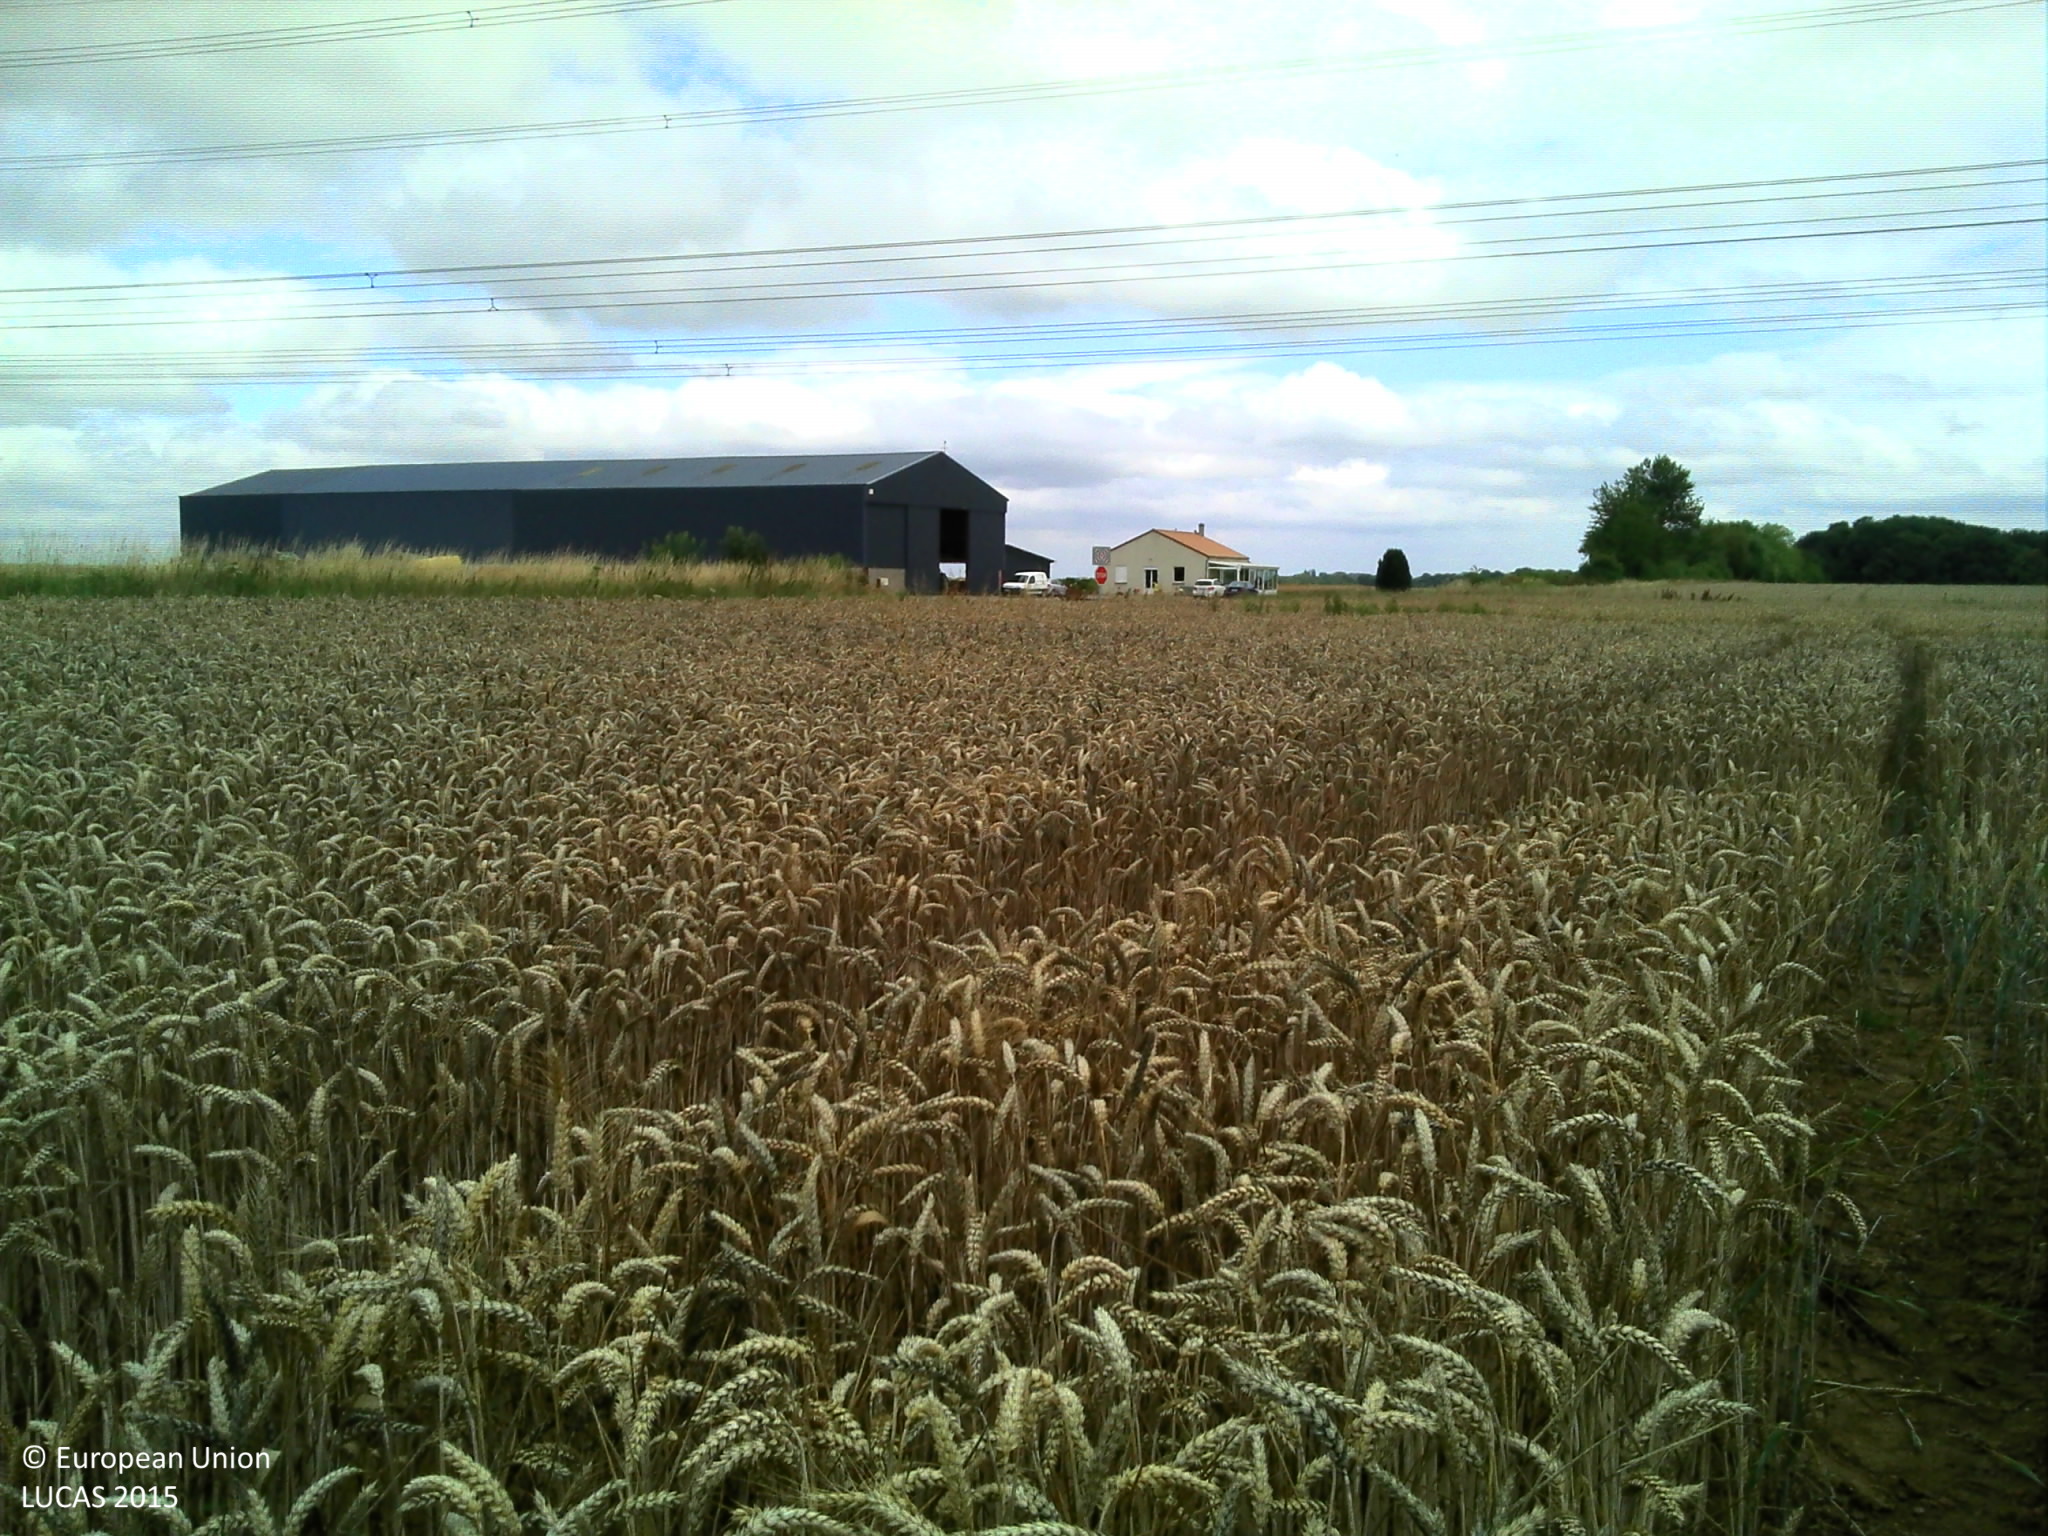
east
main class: Cropland
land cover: Common wheat
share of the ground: > 75 %
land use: Agriculture (excluding fallow land and kitchen gardens)
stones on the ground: < 10 %
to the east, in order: Common wheat; Electric lines; Grass margins; Paved roads, cycling and walking lanes; Grass margins; Tracks; Grassland without tree/shrub cover; Railways; Grass margins; Single bushes/trees; Grass margins; Common wheat; Barley
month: July
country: FR
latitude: 50.0081
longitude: 2.2138
